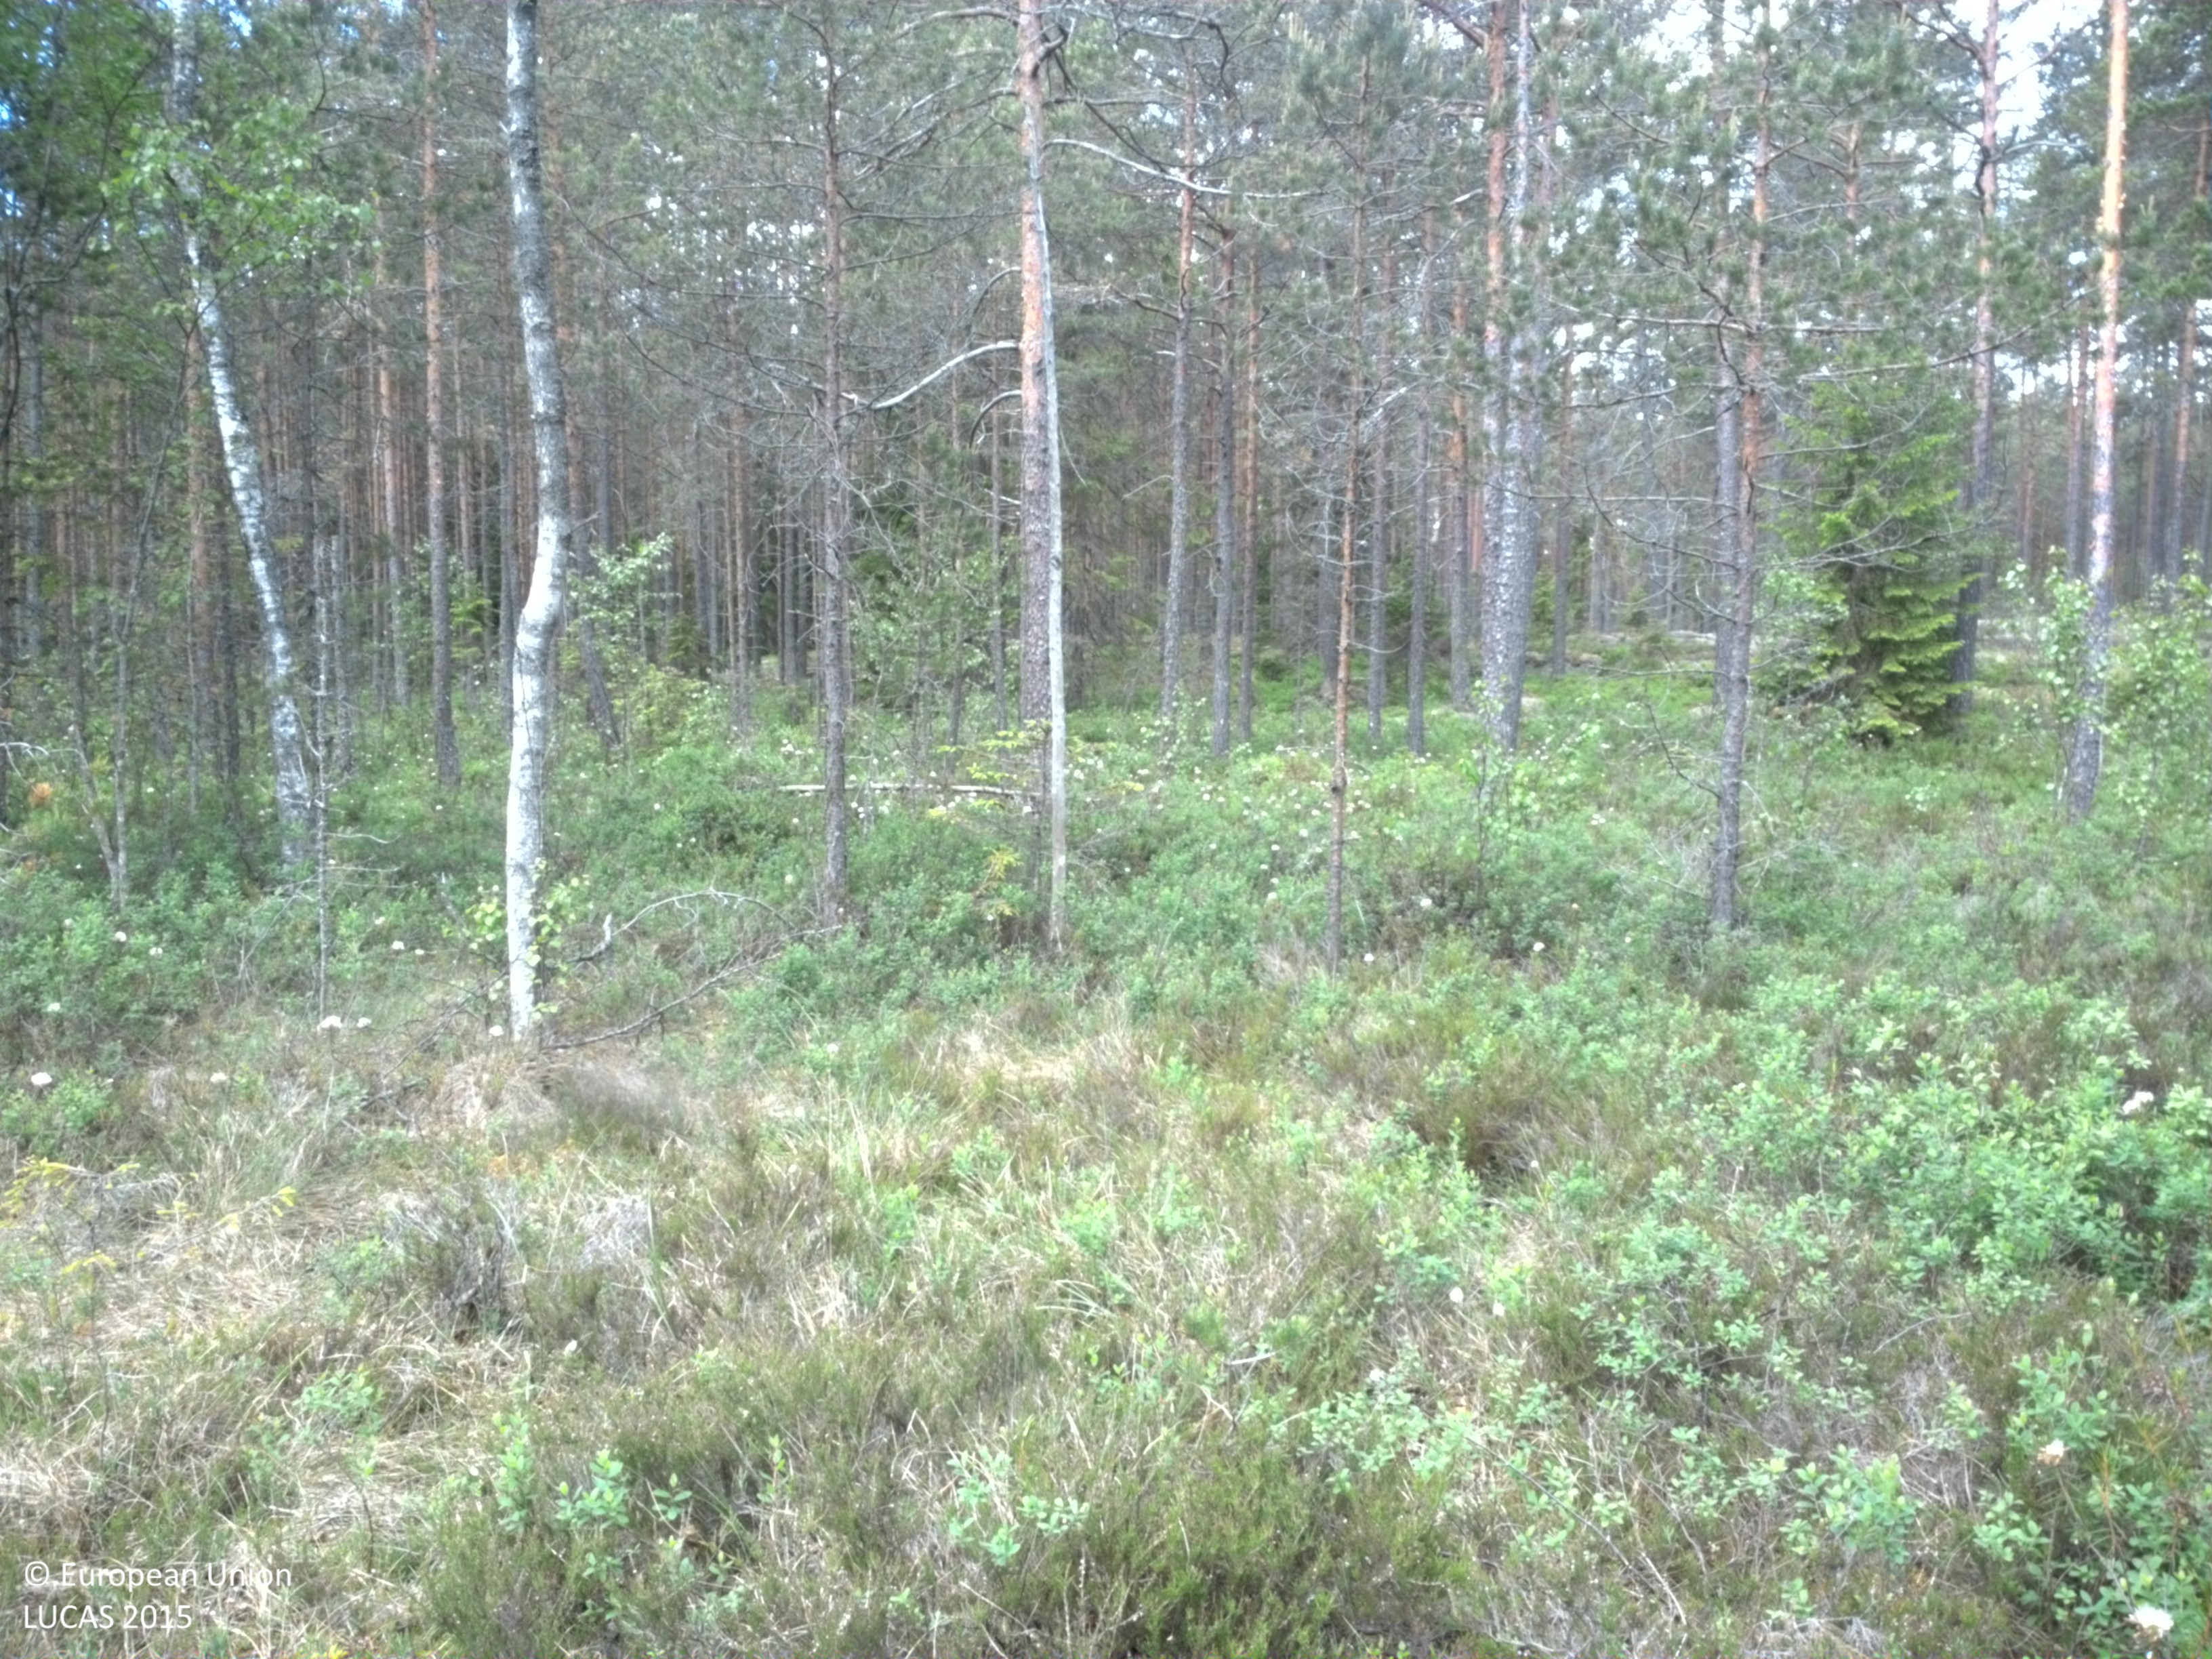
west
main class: Woodland
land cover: Pine dominated coniferous woodland
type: boreal forest
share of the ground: 25 - 50 %
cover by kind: lichens and mosses 50 %, coniferous forest trees 25 %, herbaceous plants 20 %, broadleaved forest trees 5 %
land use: Forestry
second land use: Amenities, museums, leisure
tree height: > 5 m
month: June
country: SE
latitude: 59.9297
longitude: 17.0955
